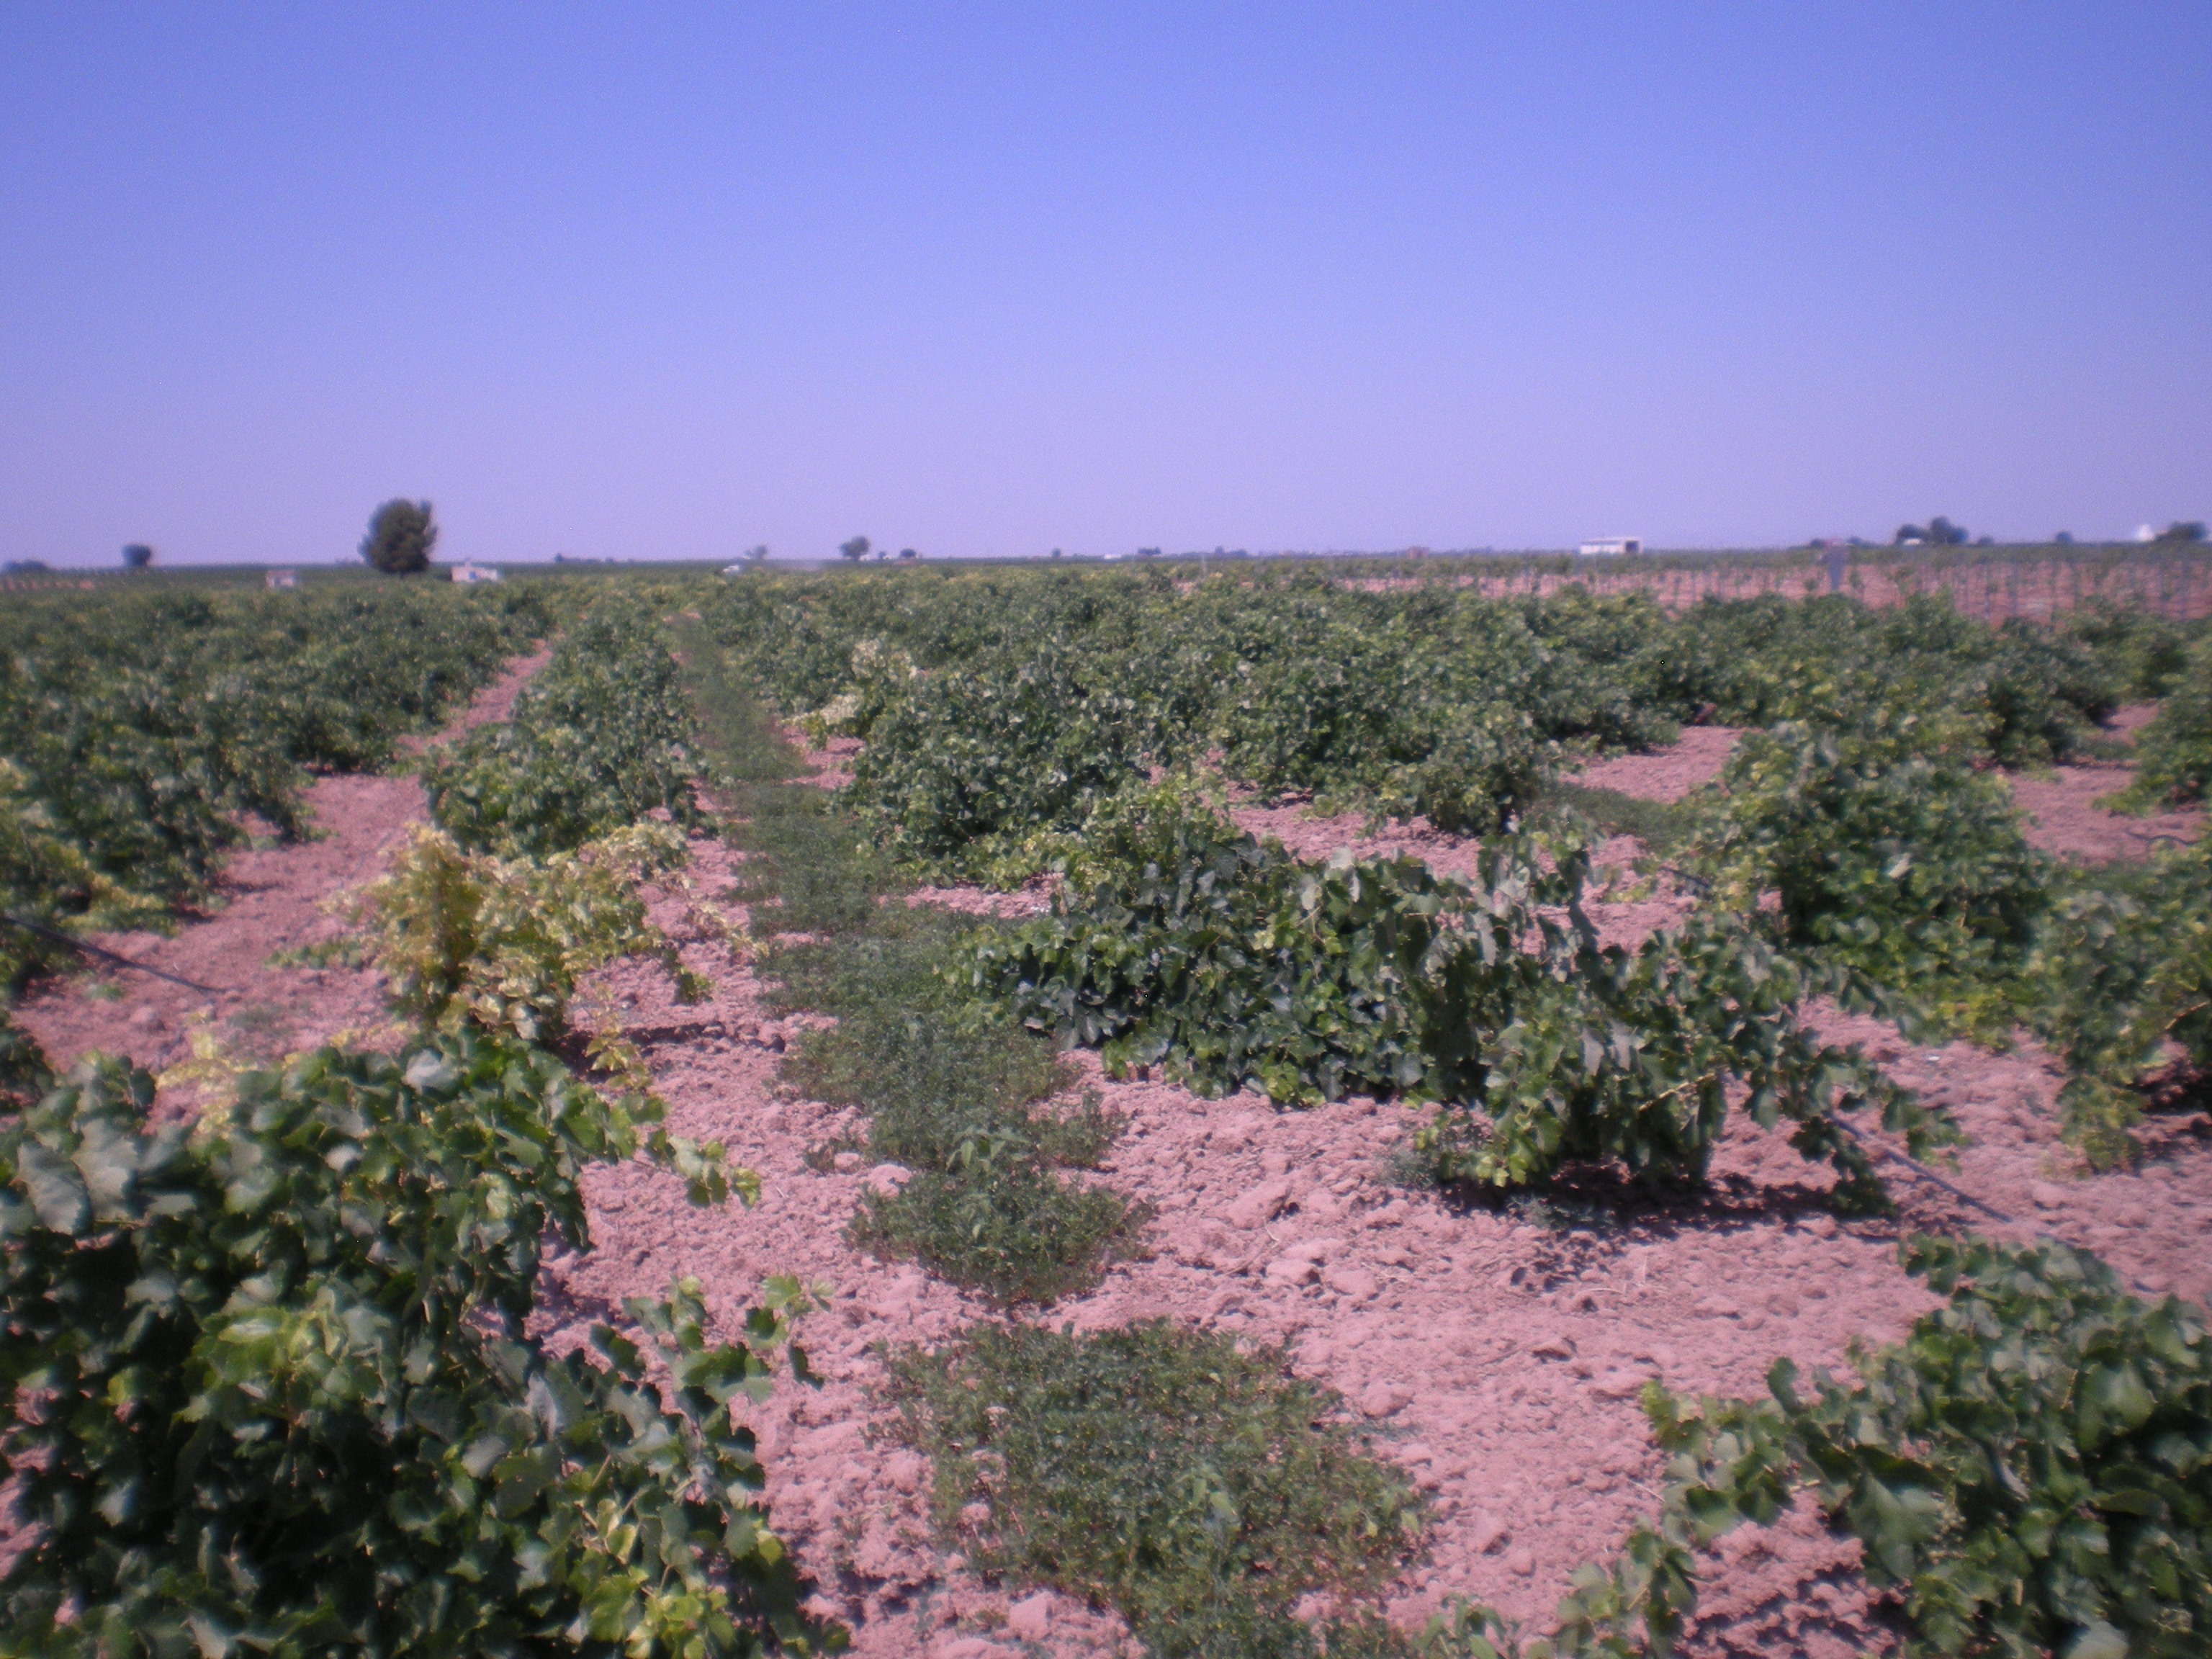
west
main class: Cropland
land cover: Vineyards
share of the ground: 25 - 50 %
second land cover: Spontaneously vegetated surfaces
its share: 10 - 25 %
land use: Agriculture (excluding fallow land and kitchen gardens)
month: July
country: ES
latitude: 39.2631
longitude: -3.0529
